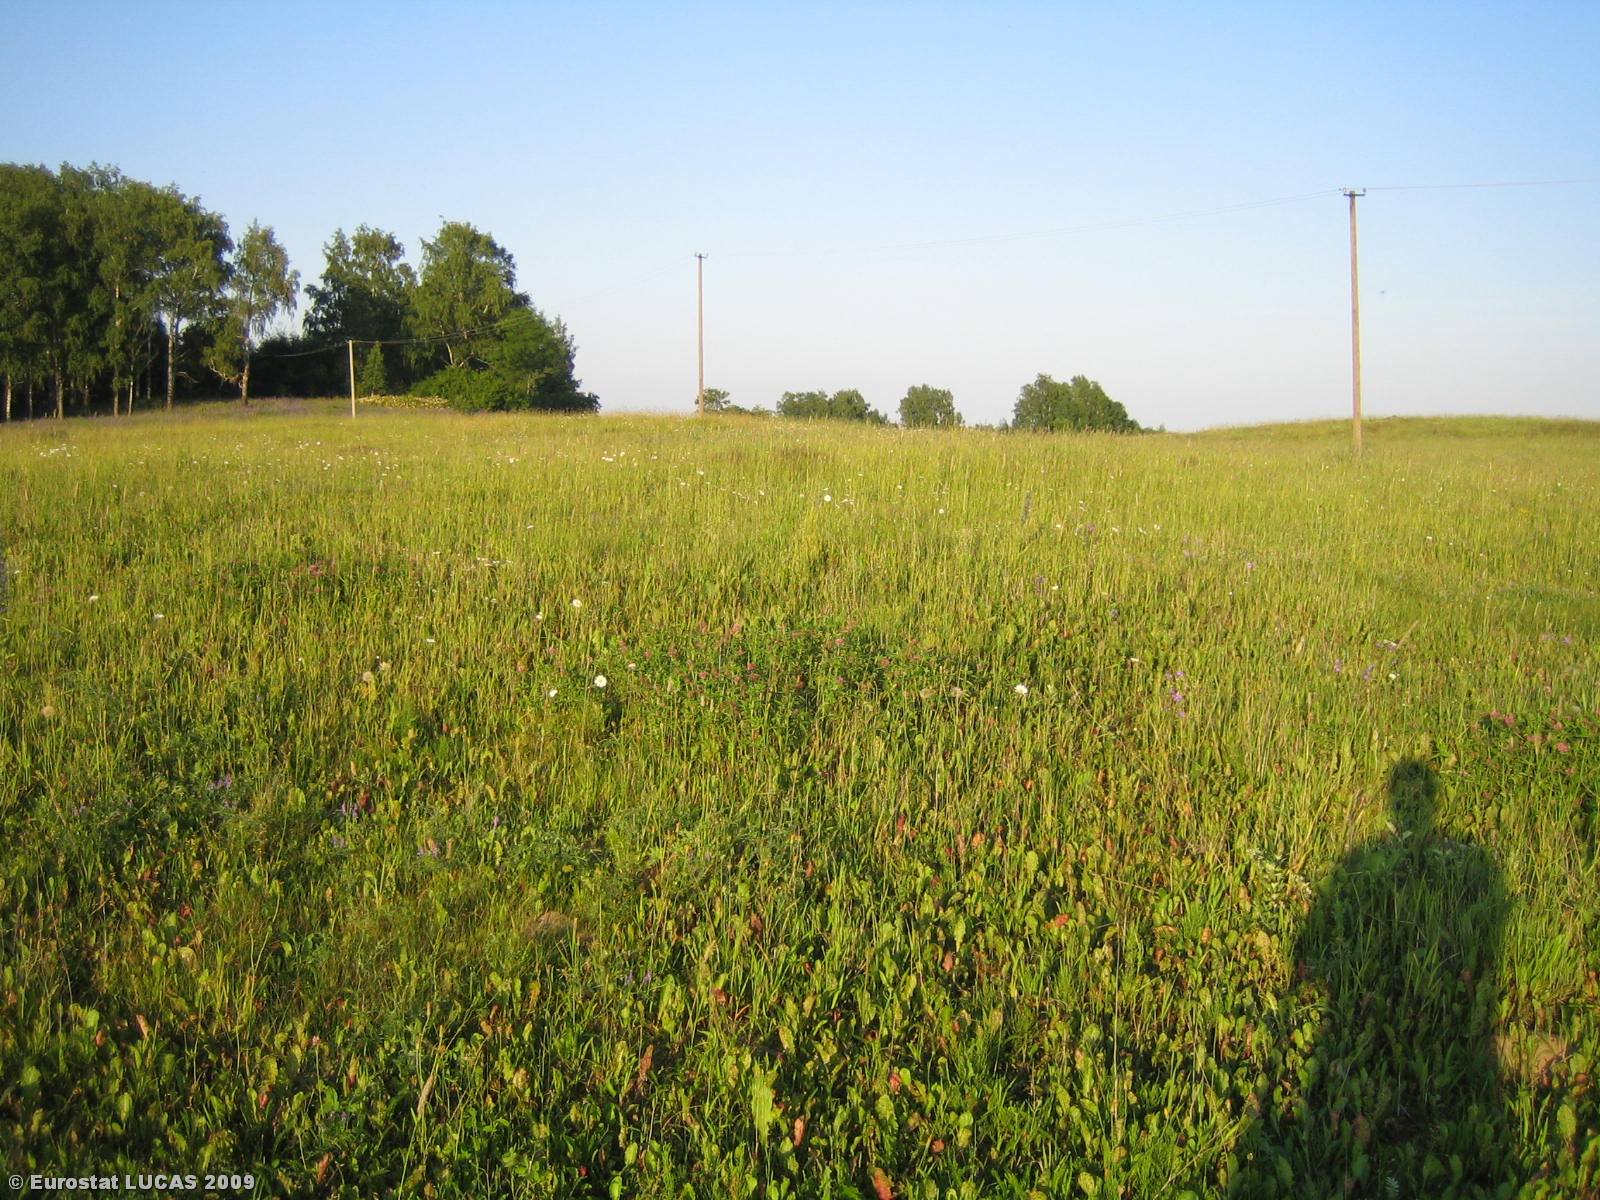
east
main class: Cropland
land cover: Clovers
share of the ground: > 75 %
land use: Agriculture (excluding fallow land and kitchen gardens)
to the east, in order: Clovers; Grassland without tree/shrub cover
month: July
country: LT
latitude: 55.6135
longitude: 25.8673
